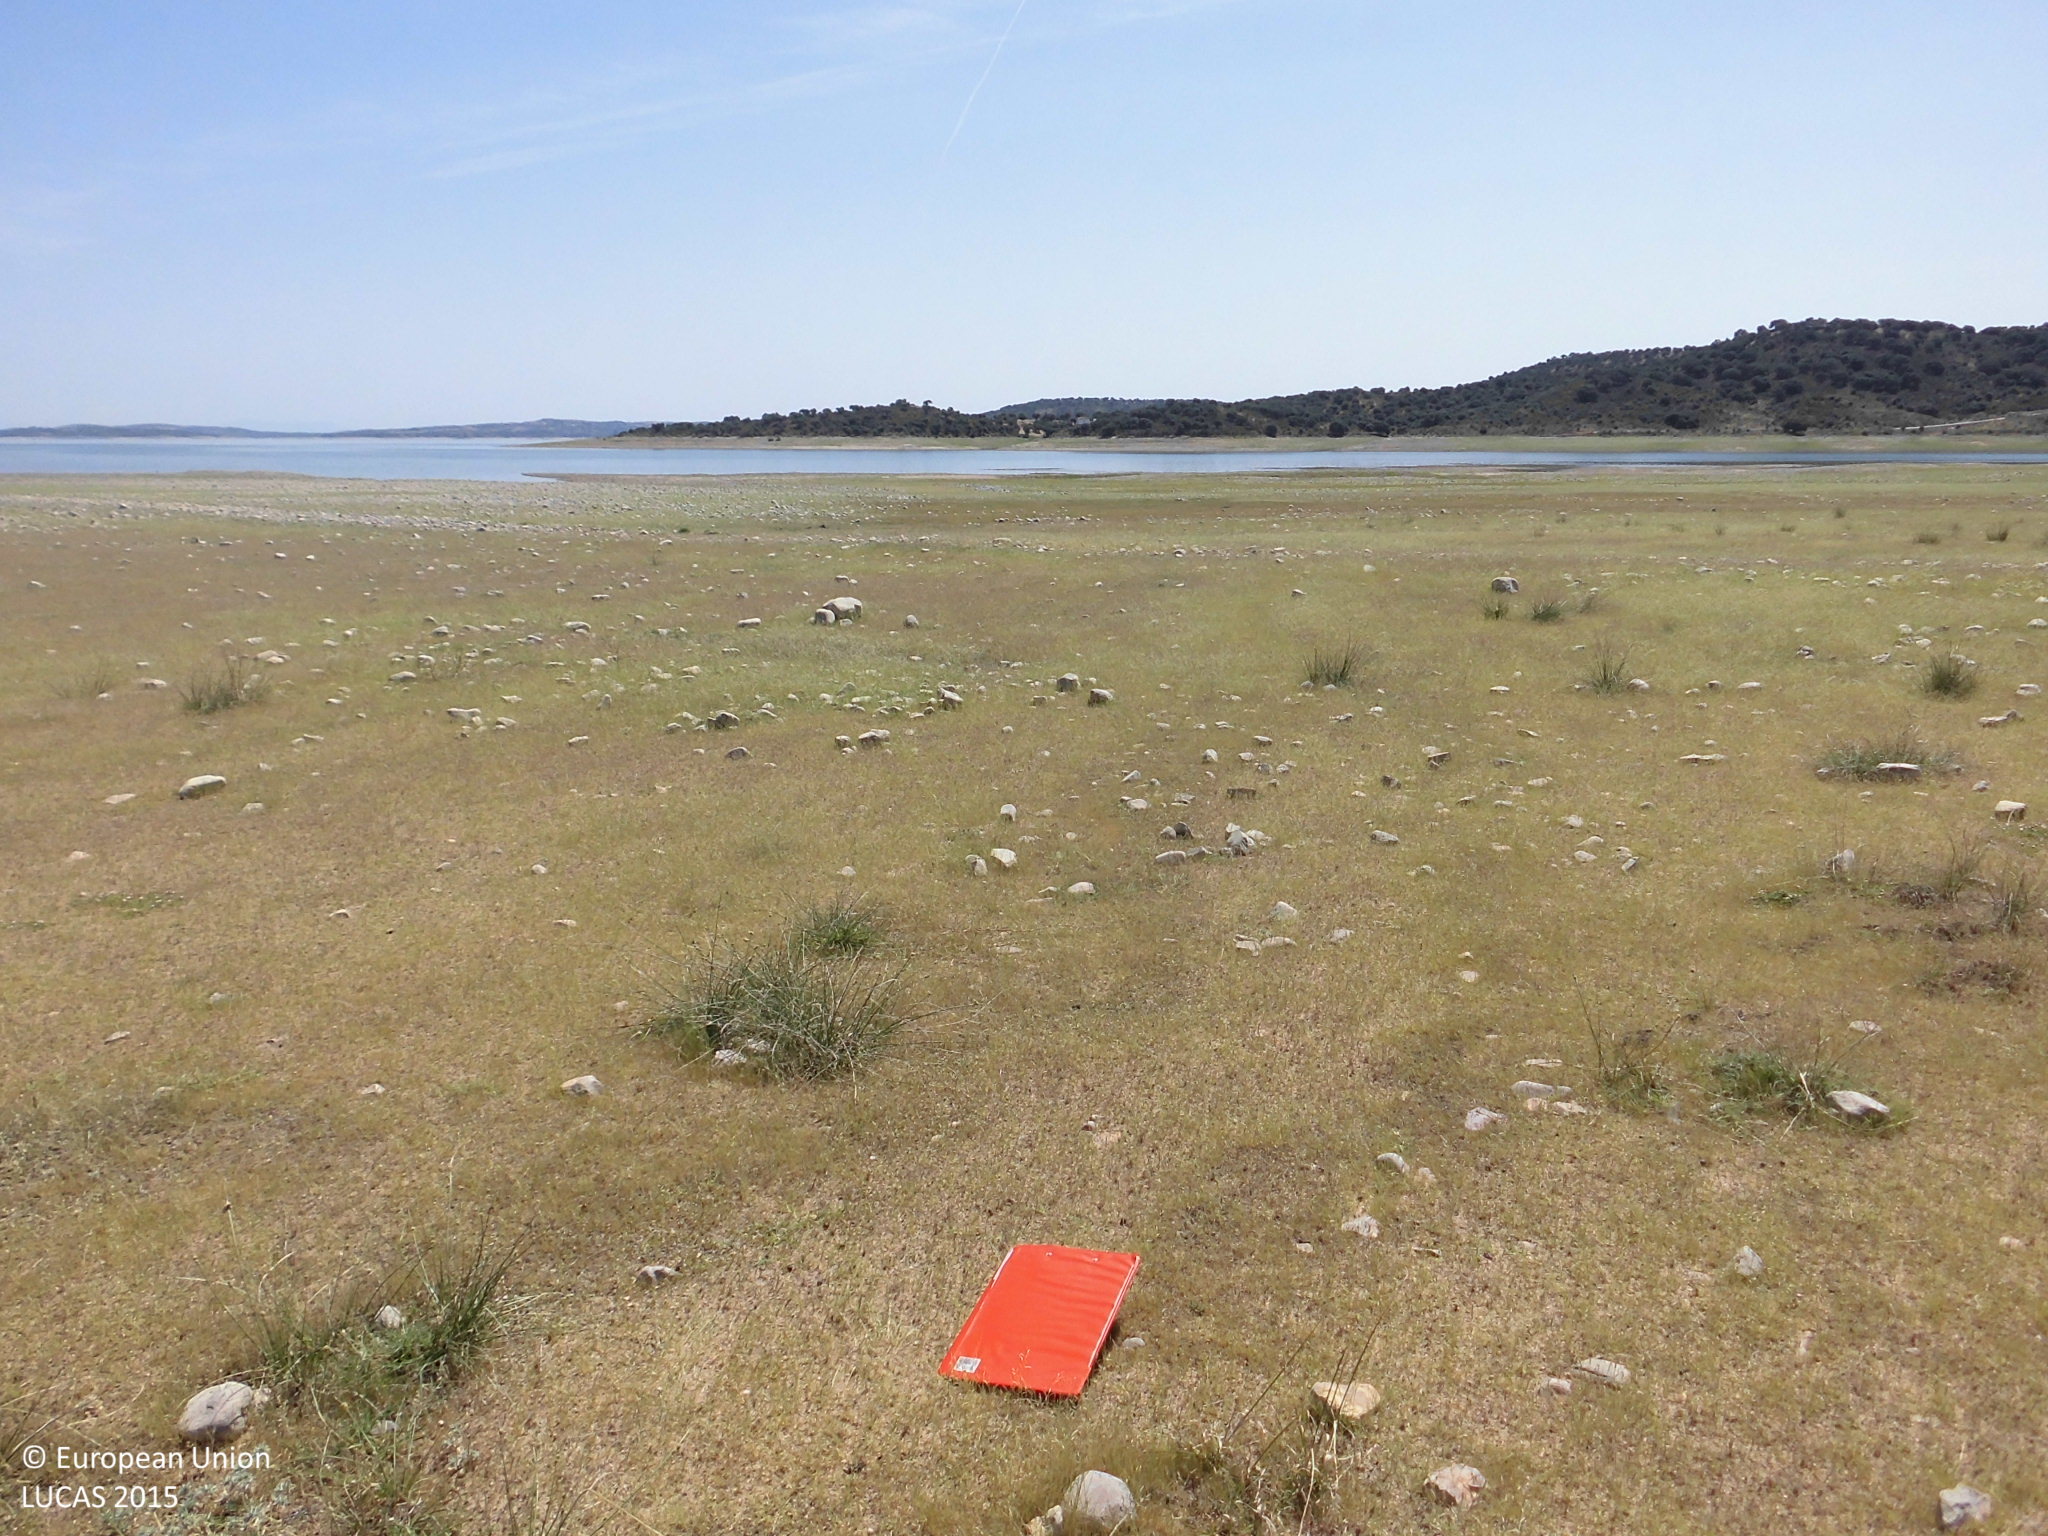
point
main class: Grassland
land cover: Spontaneously vegetated surfaces
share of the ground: > 75 %
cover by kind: herbaceous plants 100 %
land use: Semi-natural and natural areas not in use
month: July
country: ES
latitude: 39.7876
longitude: -5.4579
